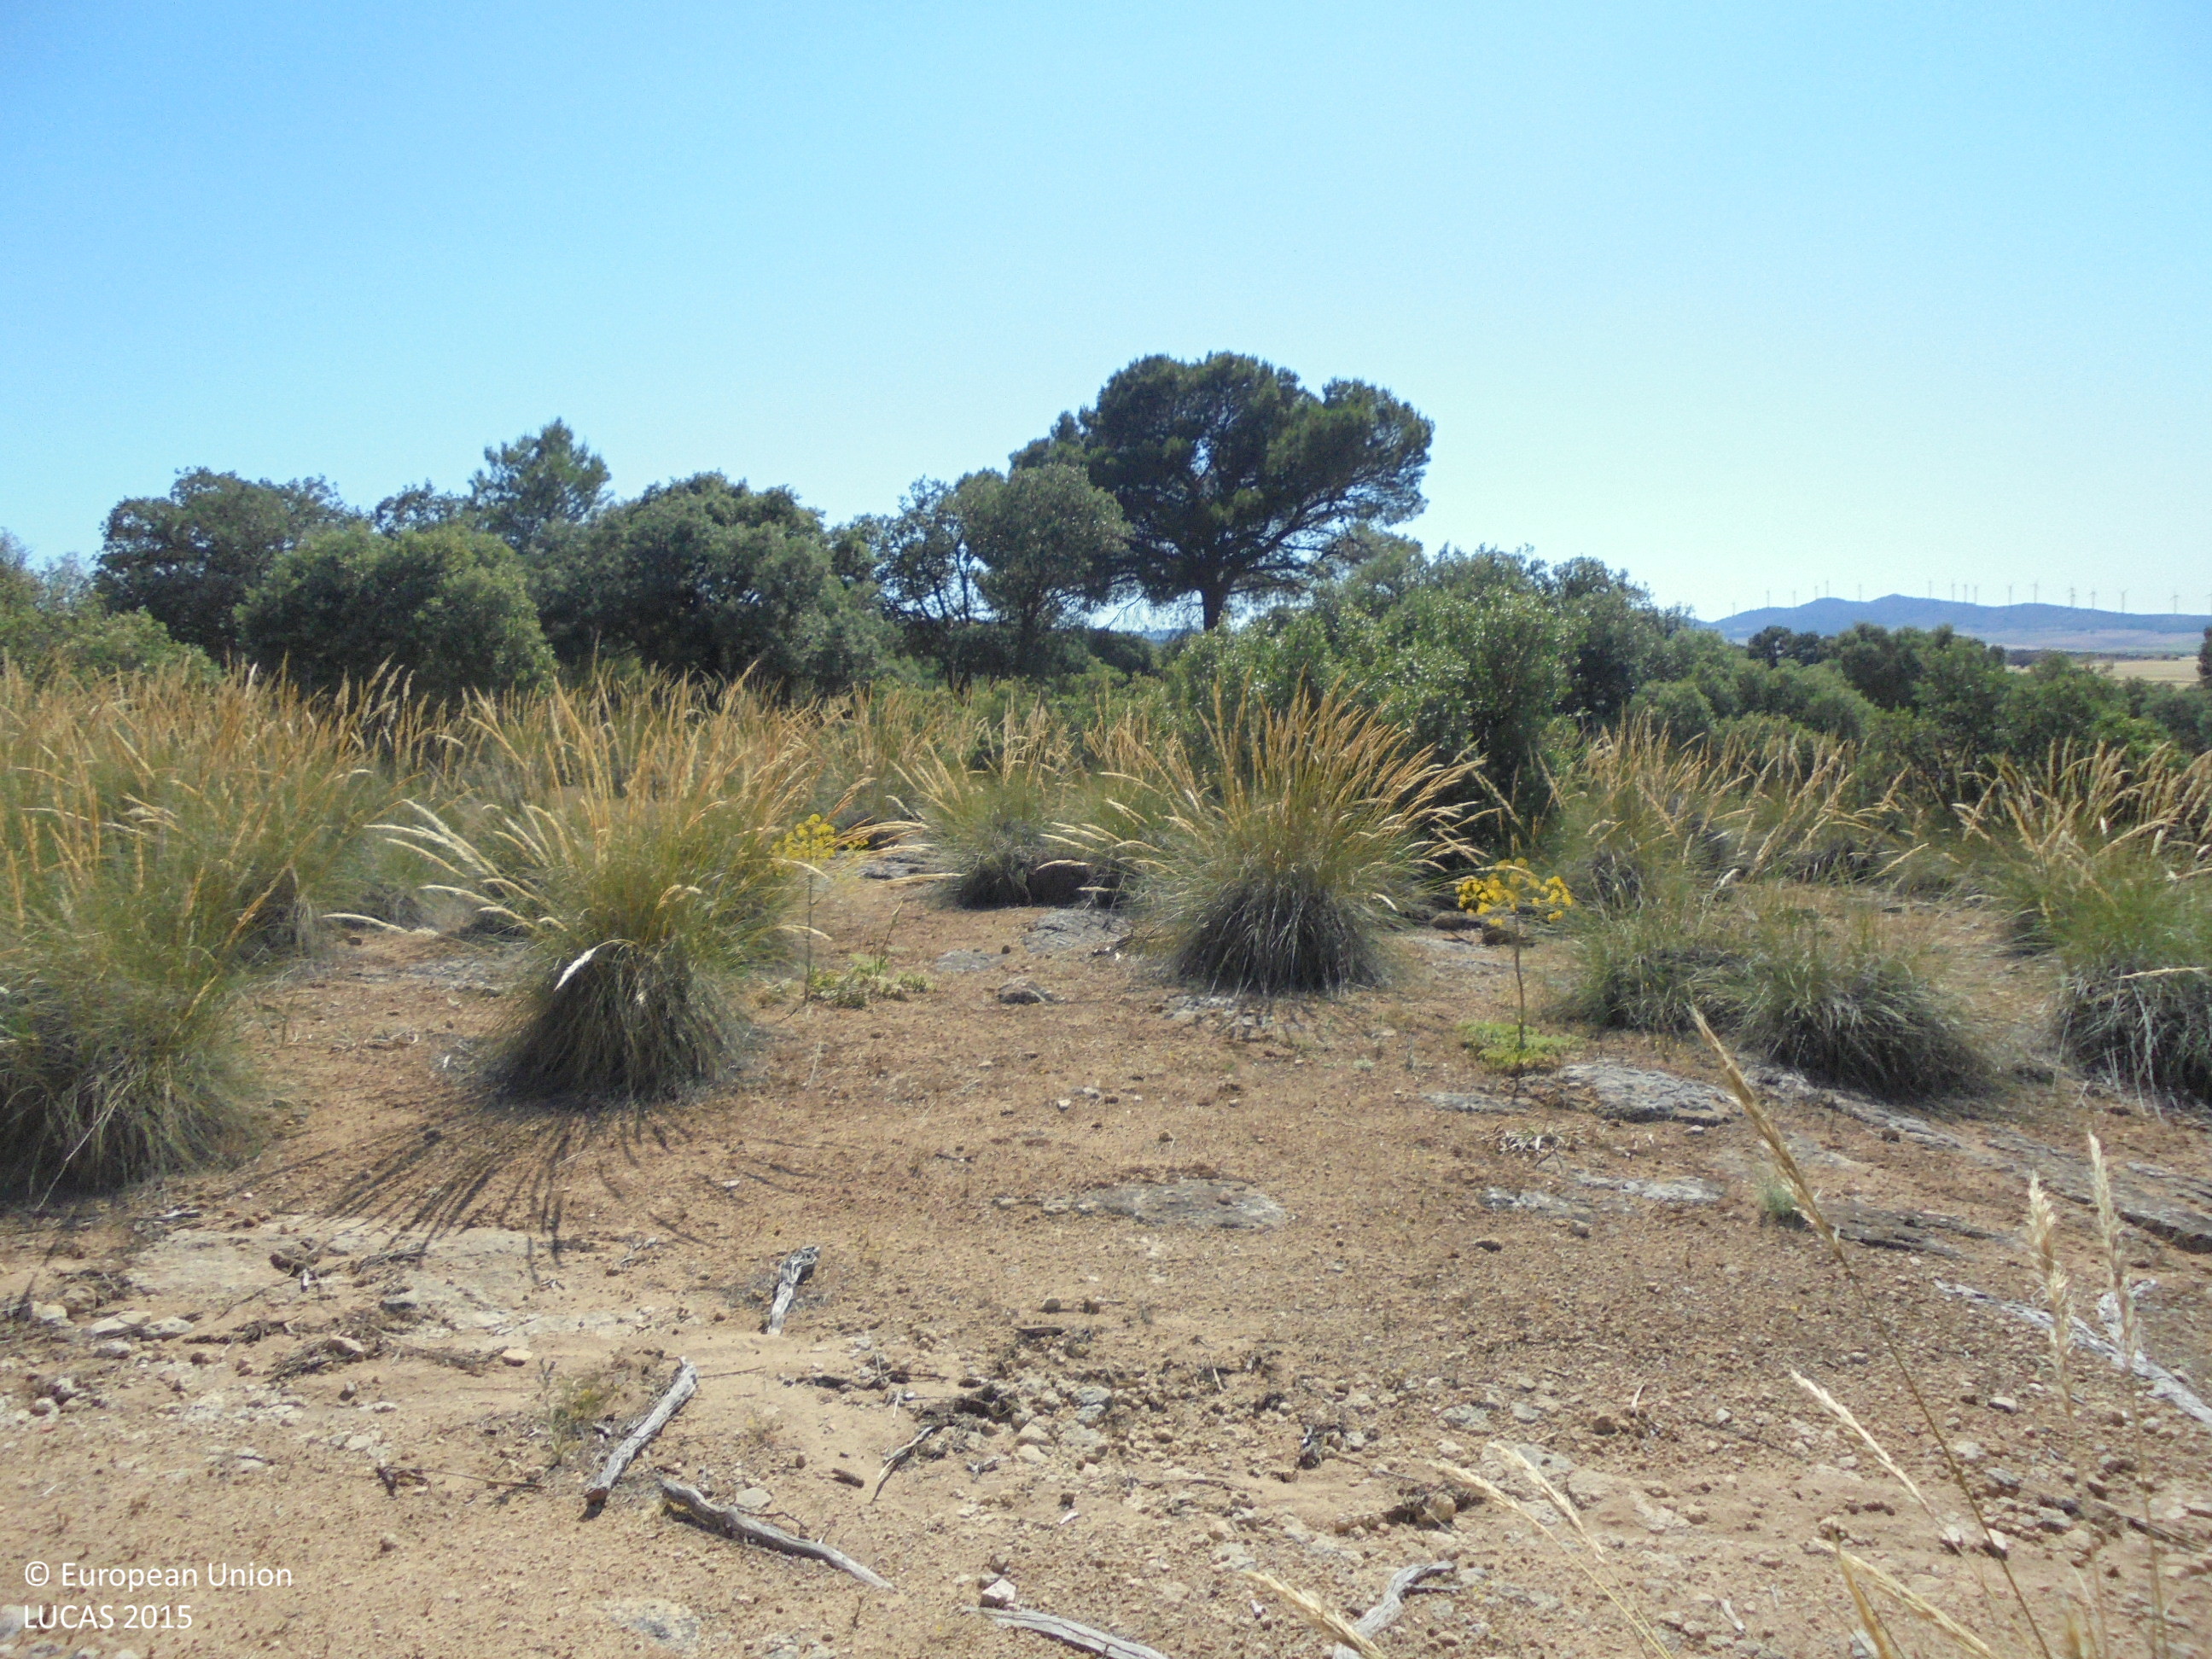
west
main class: Woodland
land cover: Pine dominated coniferous woodland
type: coniferous forest of the mediterranean region
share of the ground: 50 - 75 %
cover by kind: coniferous forest trees 60 %, shrubs 30 %, unconsolidated bare surface 10 %
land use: Semi-natural and natural areas not in use
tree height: > 5 m
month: June
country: ES
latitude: 38.7635
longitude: -1.6774
